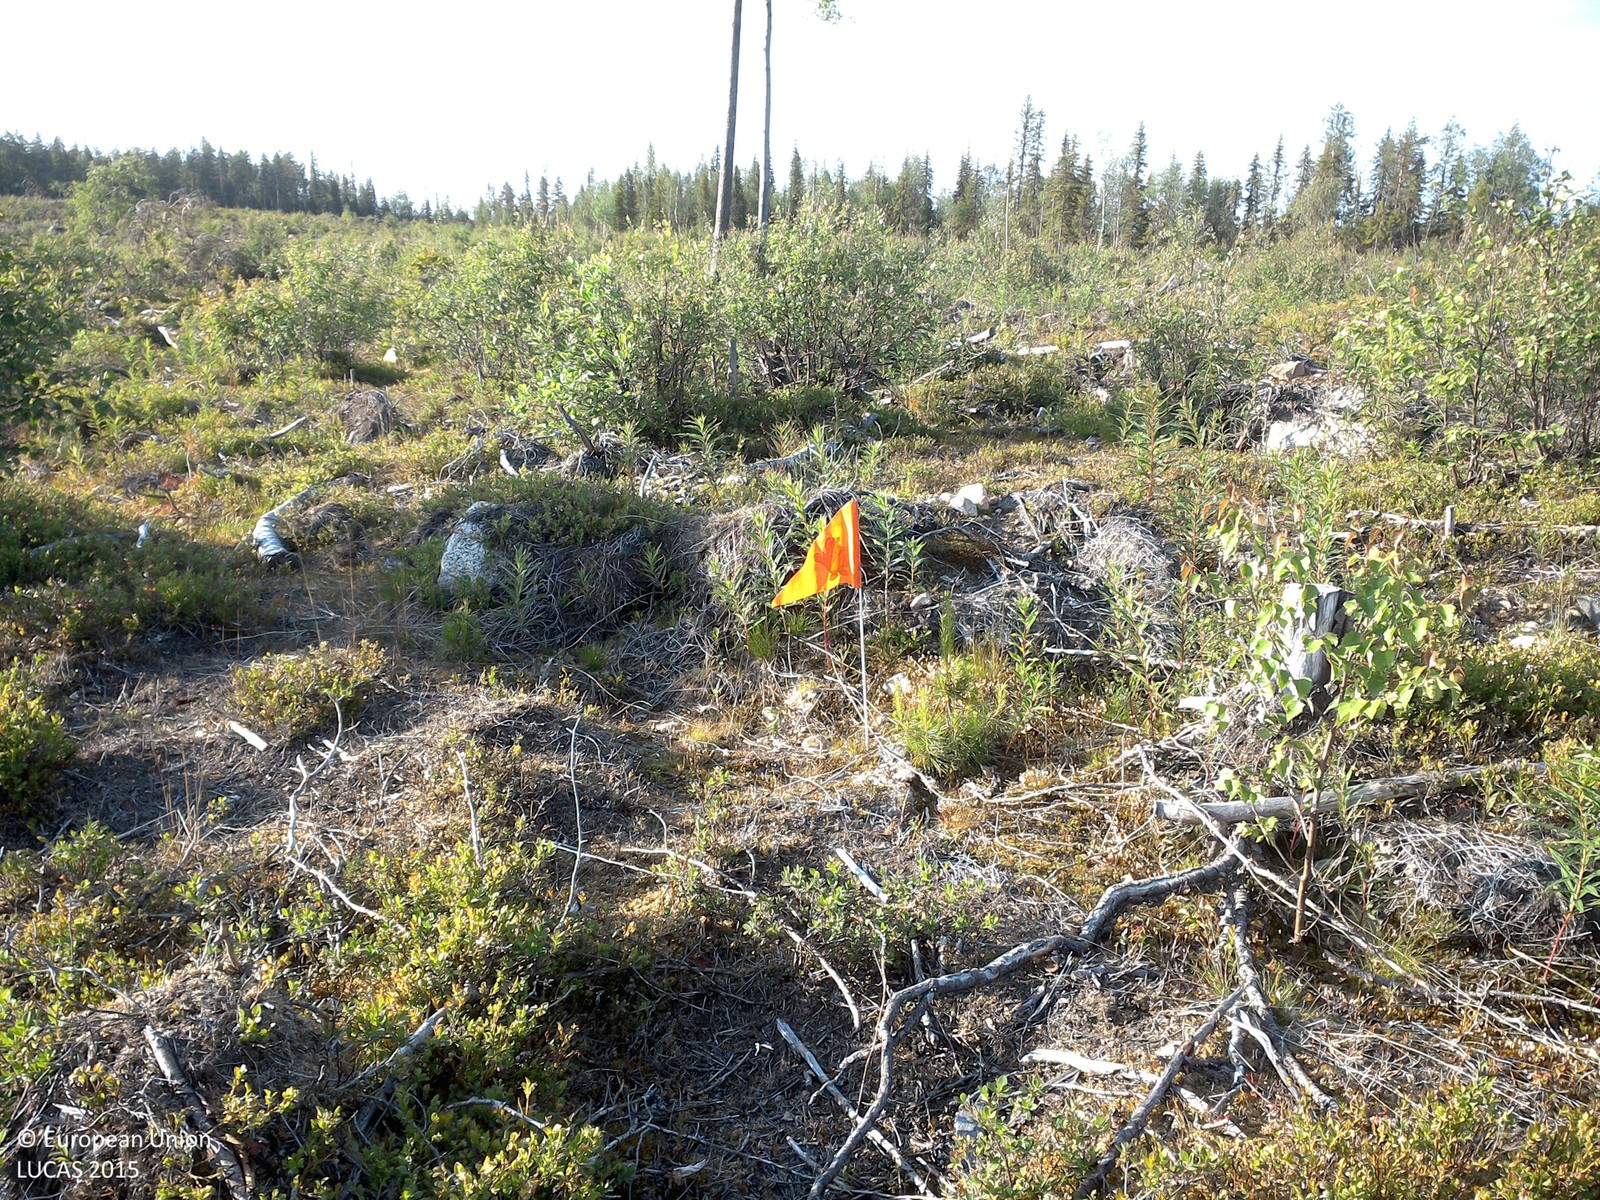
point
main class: Woodland
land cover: Broadleaved woodland
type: boreal forest
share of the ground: 10 - 25 %
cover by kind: shrubs 70 %, broadleaved forest trees 15 %, unconsolidated bare surface 10 %, lichens and mosses 5 %
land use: Forestry
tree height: < 5 m
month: July
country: SE
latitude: 67.1293
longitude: 22.8092
